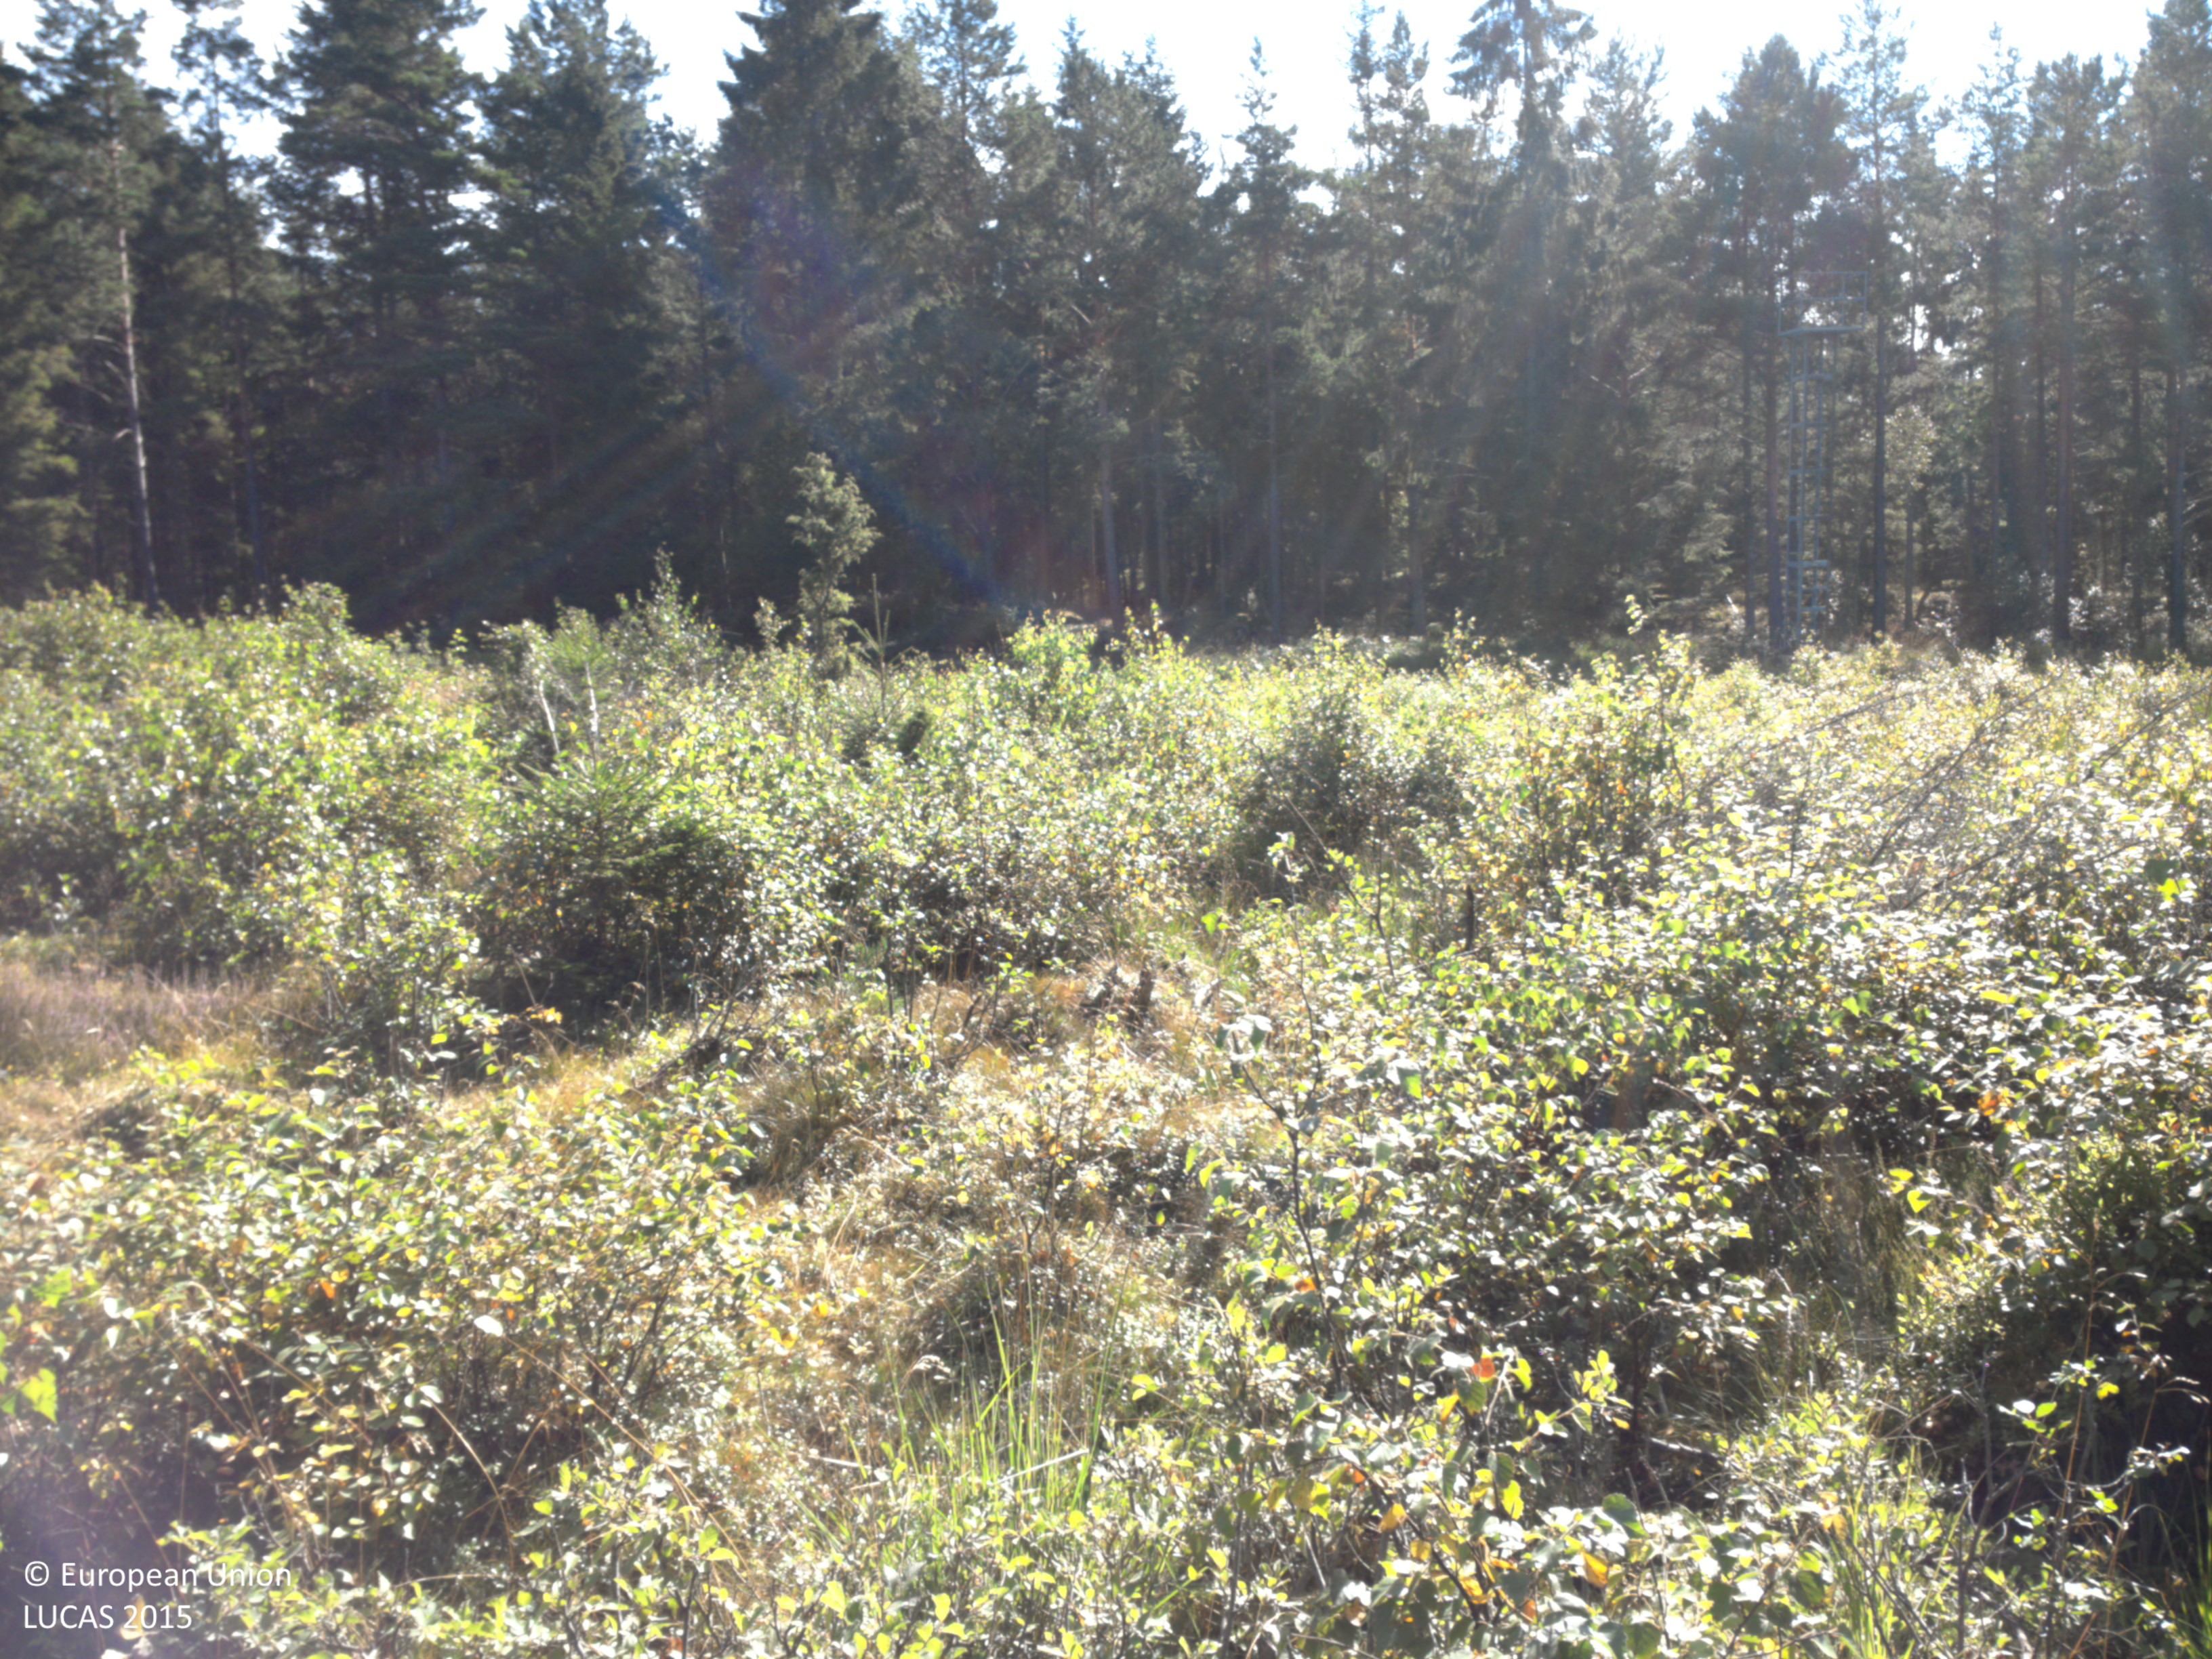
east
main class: Woodland
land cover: Spruce dominated mixed woodland
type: boreal forest
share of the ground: 50 - 75 %
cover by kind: broadleaved forest trees 45 %, lichens and mosses 25 %, coniferous forest trees 15 %, shrubs 15 %
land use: Electricity, gas and thermal power distribution
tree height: < 5 m
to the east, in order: Spruce dominated mixed woodland; Electric lines; Tracks; Spruce dominated coniferous woodland; Tracks; Pine dominated coniferous woodland; Pine dominated mixed woodland; Dry stone walls; Spruce dominated mixed woodland
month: August
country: SE
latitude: 58.0213
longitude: 12.2138
